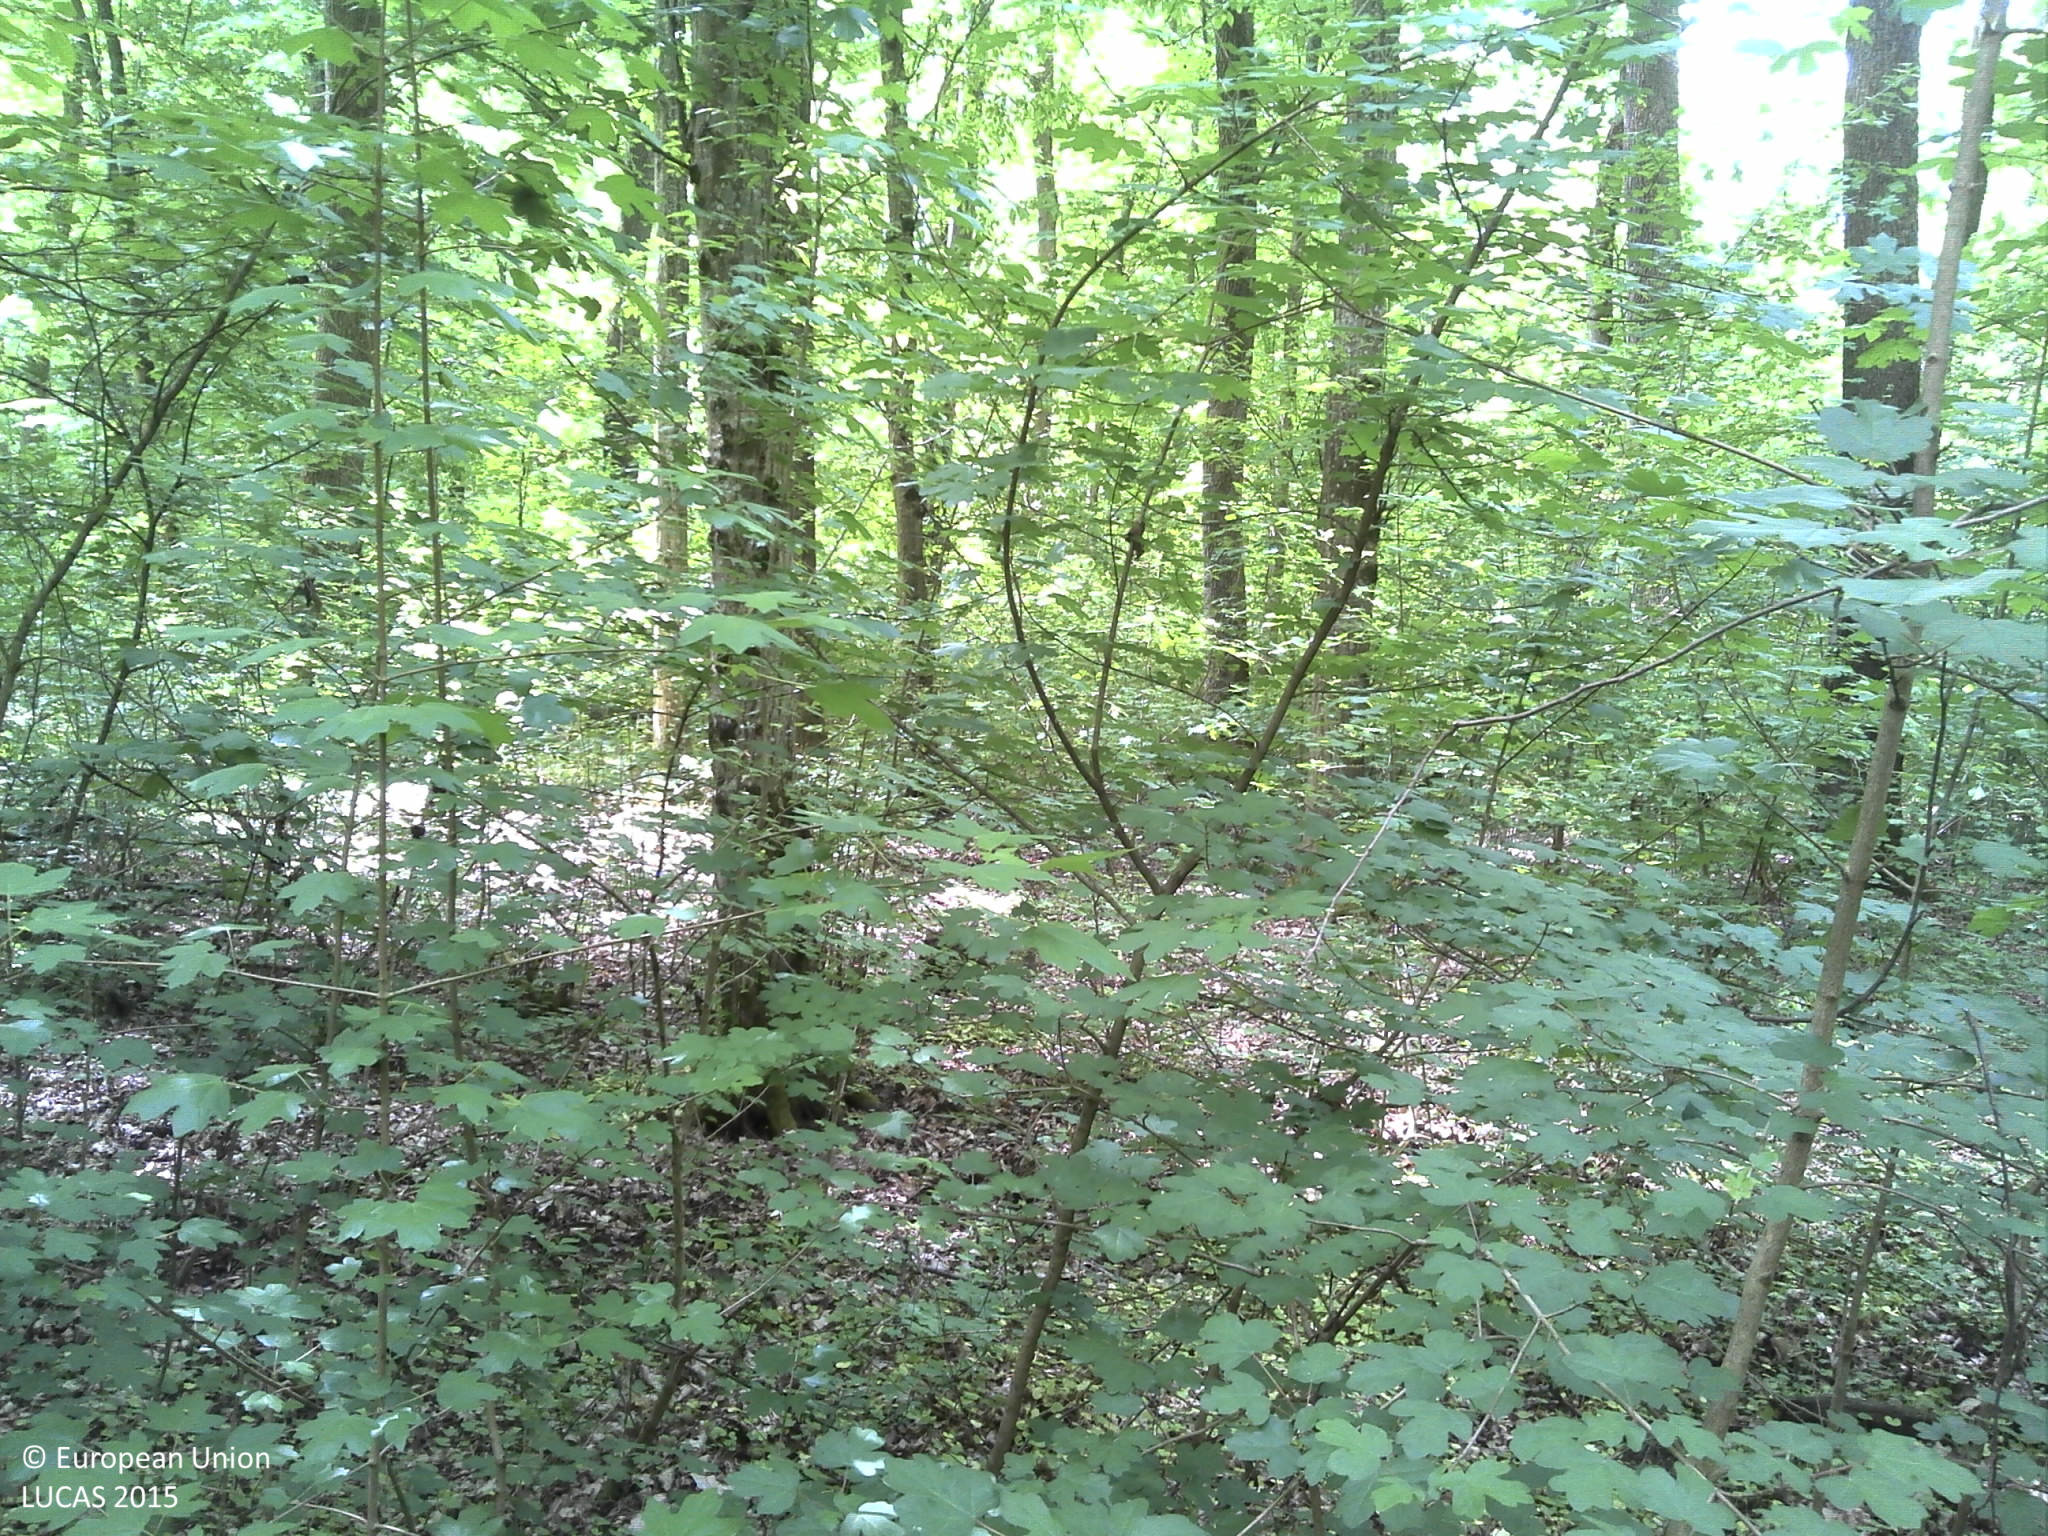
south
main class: Woodland
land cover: Broadleaved woodland
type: mesophytic deciduous forest
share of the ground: > 75 %
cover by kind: broadleaved forest trees 100 %
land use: Forestry
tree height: > 5 m
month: April
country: HR
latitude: 45.0969
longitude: 18.8381
